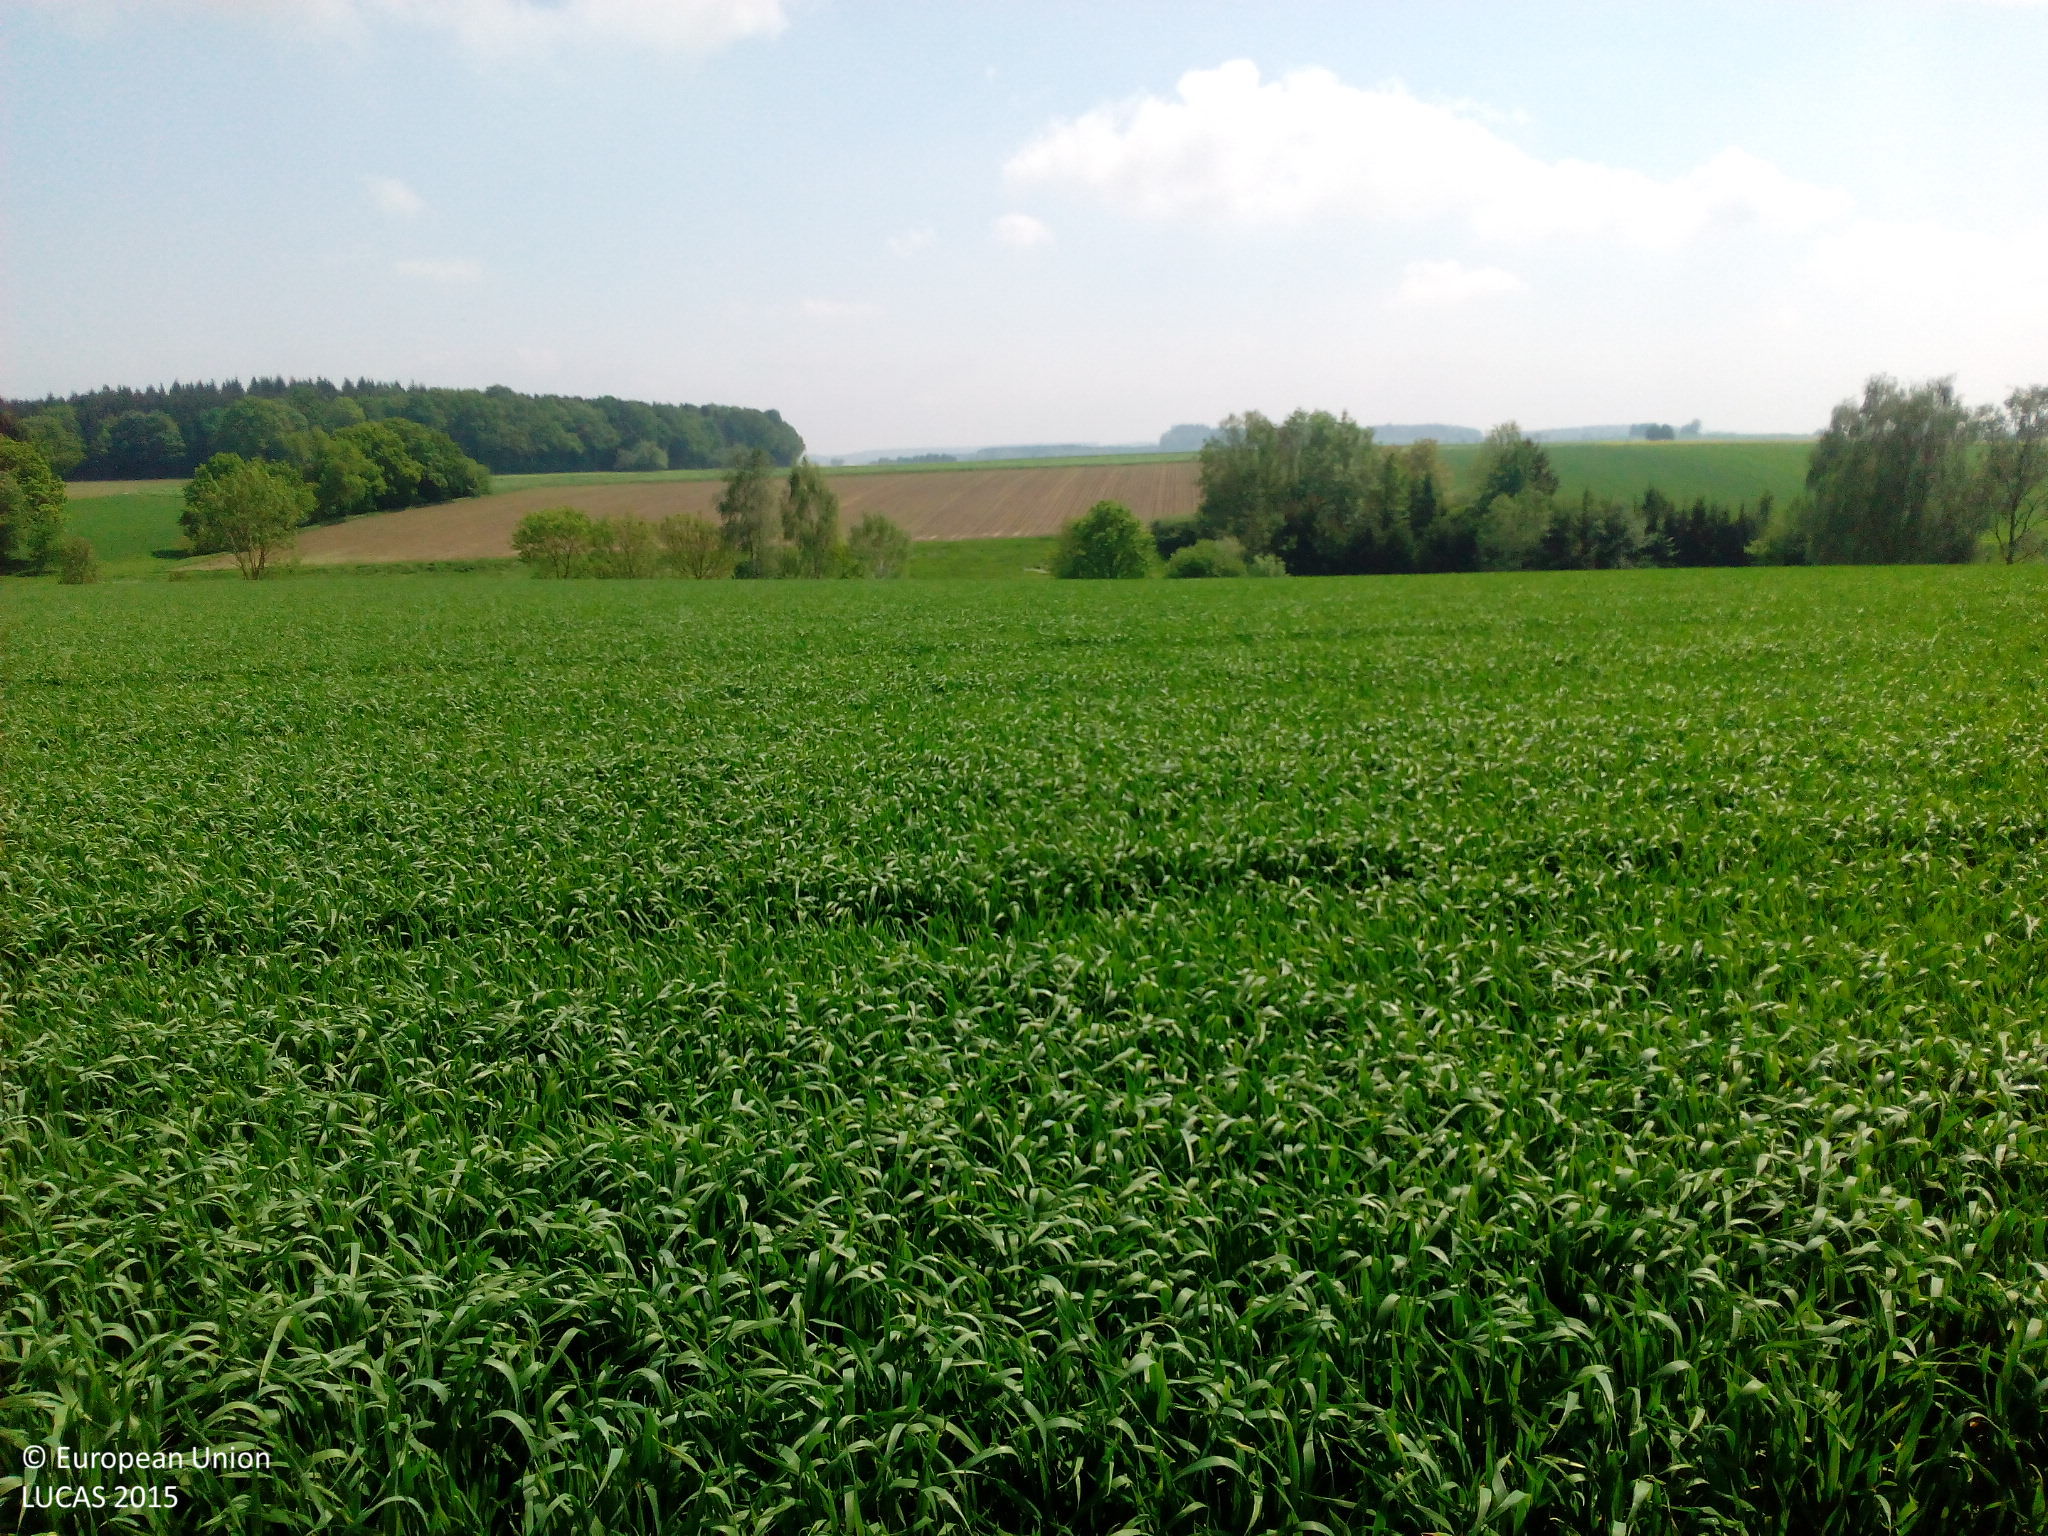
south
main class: Cropland
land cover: Common wheat
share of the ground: > 75 %
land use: Agriculture (excluding fallow land and kitchen gardens)
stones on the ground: < 10 %
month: May
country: DE
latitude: 48.0971
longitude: 9.6645
